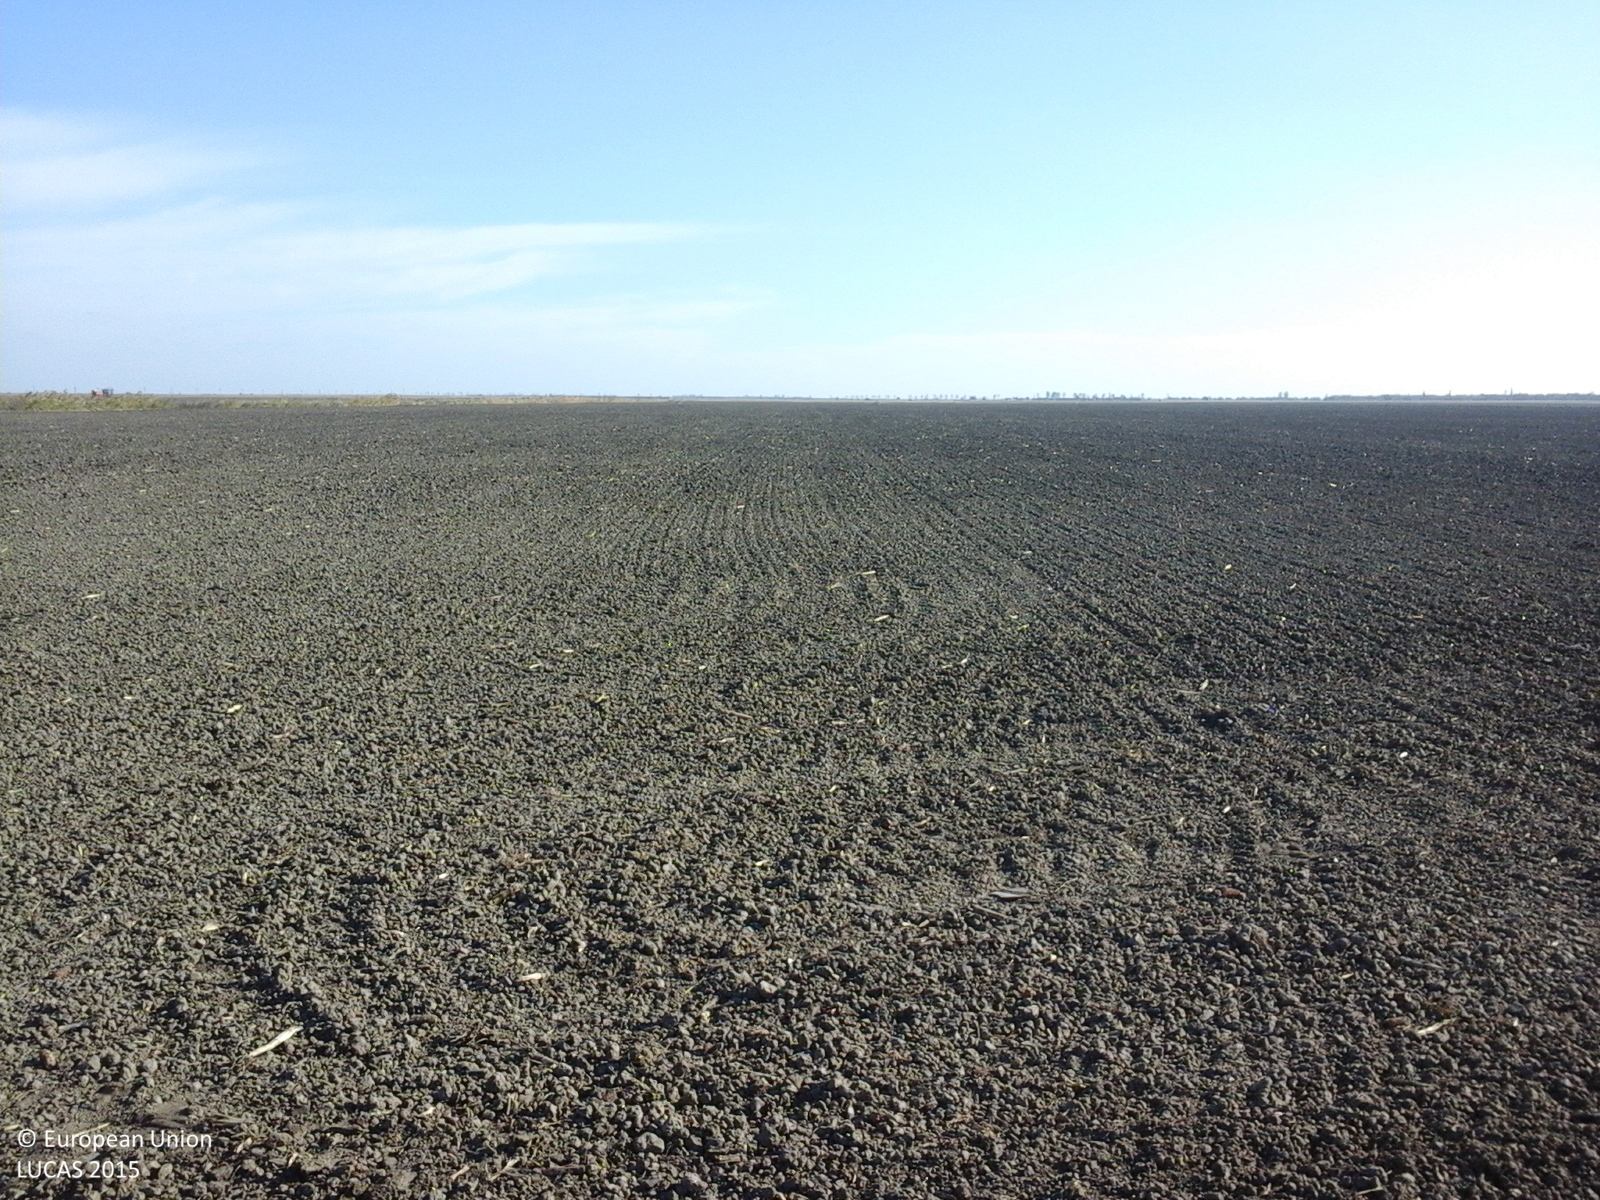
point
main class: Cropland
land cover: Common wheat
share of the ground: > 75 %
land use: Agriculture (excluding fallow land and kitchen gardens)
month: October
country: RO
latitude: 45.4194
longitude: 27.4415
